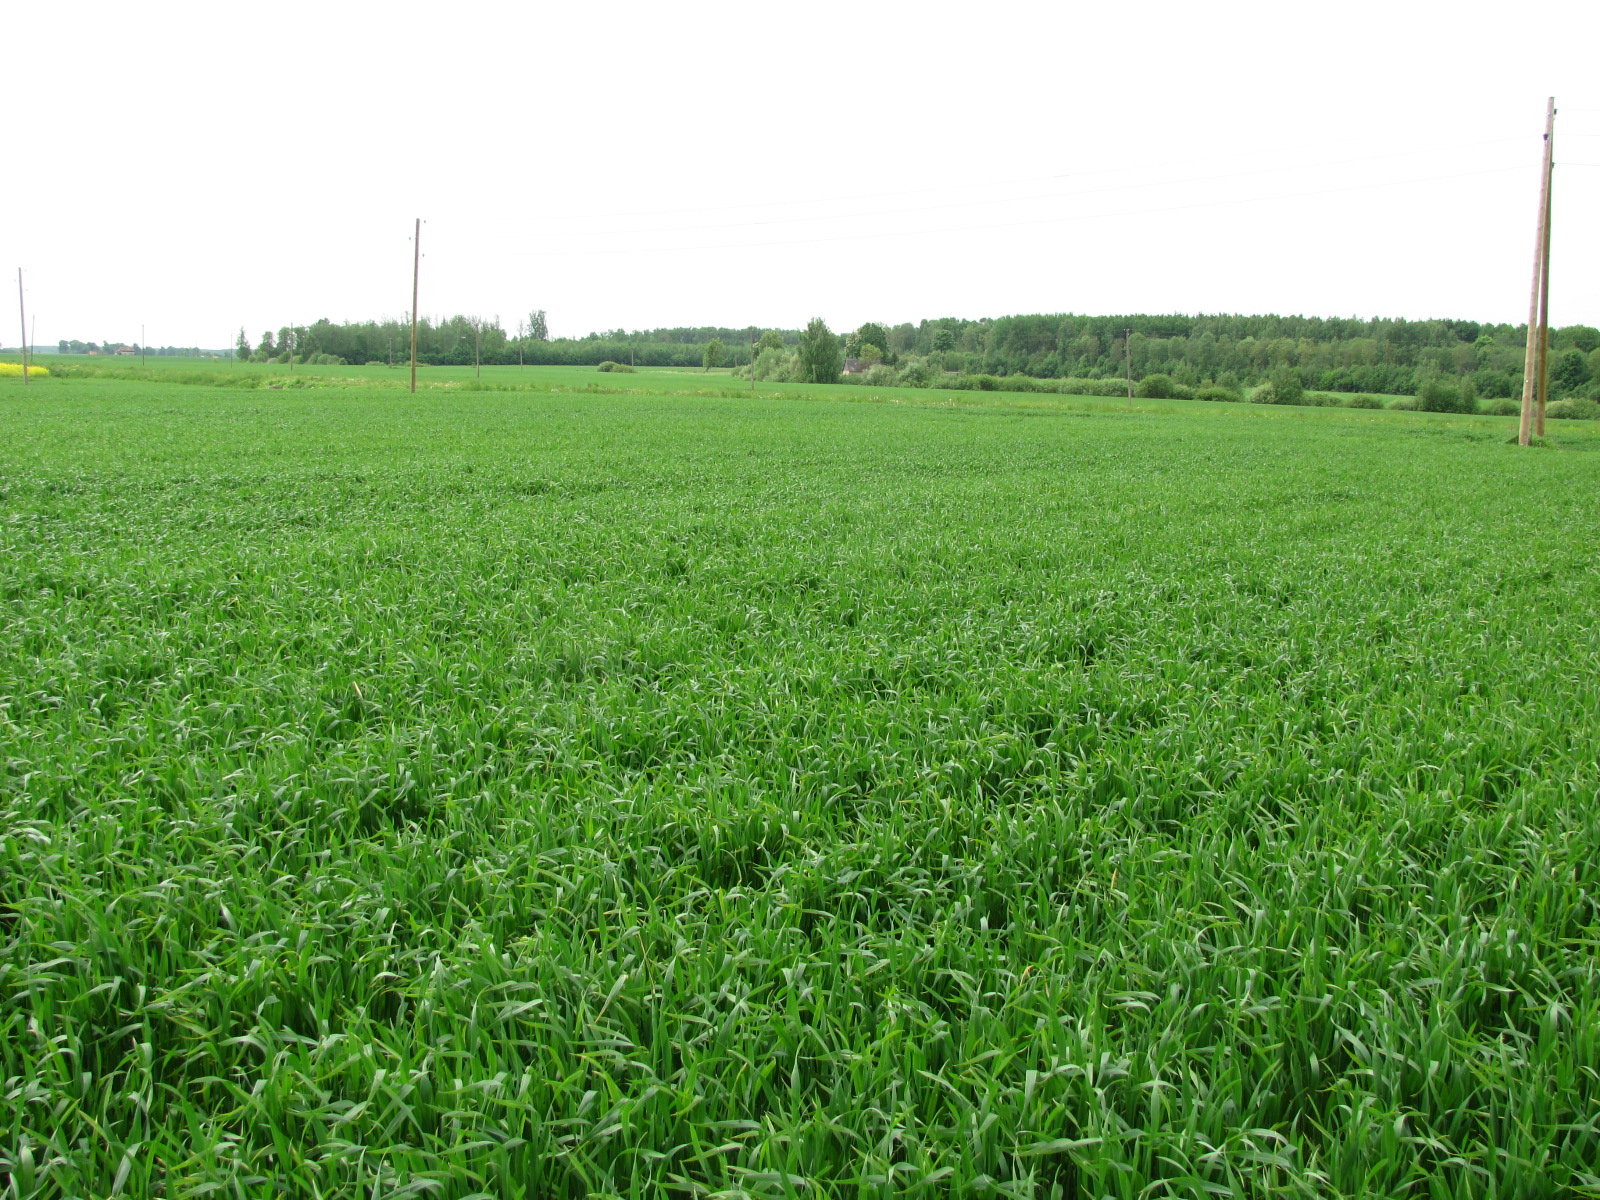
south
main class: Cropland
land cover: Common wheat
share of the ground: > 75 %
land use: Agriculture (excluding fallow land and kitchen gardens)
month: May
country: LV
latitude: 56.4440
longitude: 24.1194
